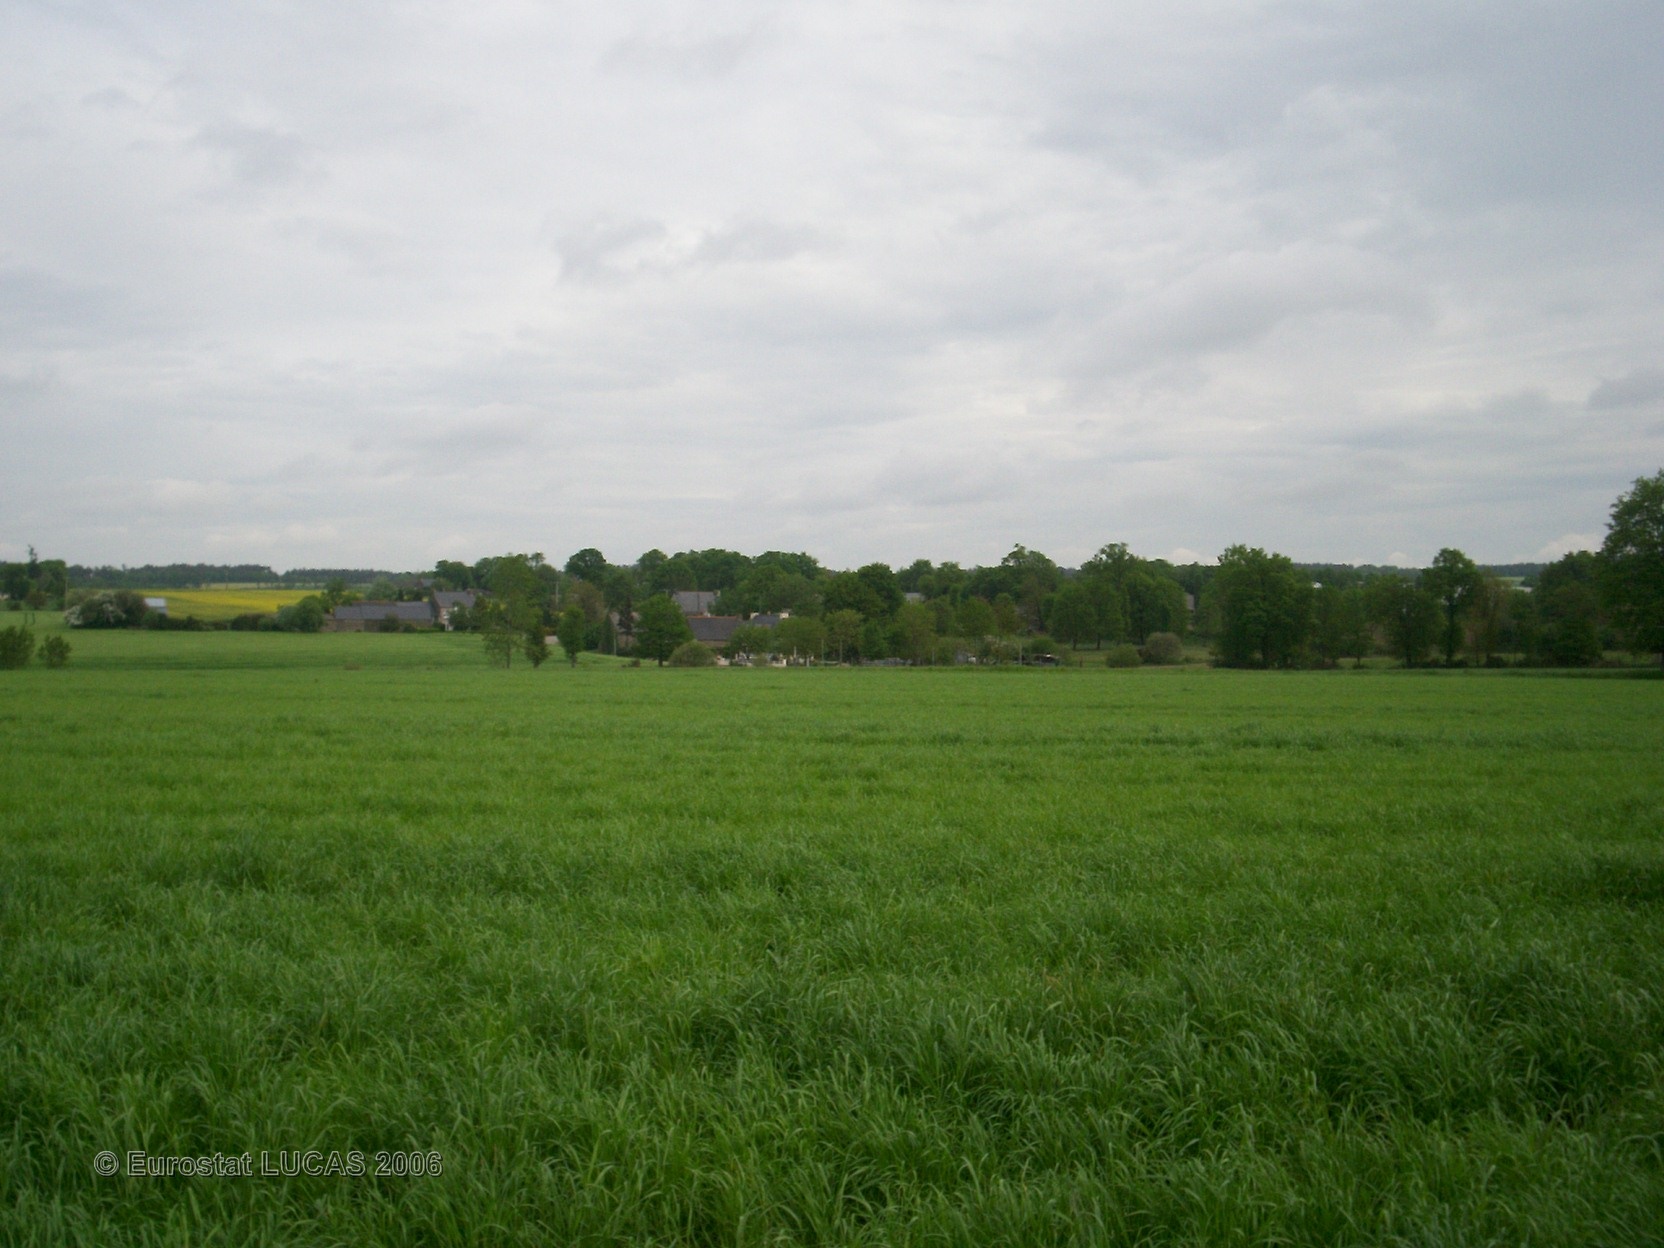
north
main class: Grassland
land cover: Grassland without tree/shrub cover
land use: Agriculture (excluding fallow land and kitchen gardens)
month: May
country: FR
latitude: 47.8519
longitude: -2.3654
